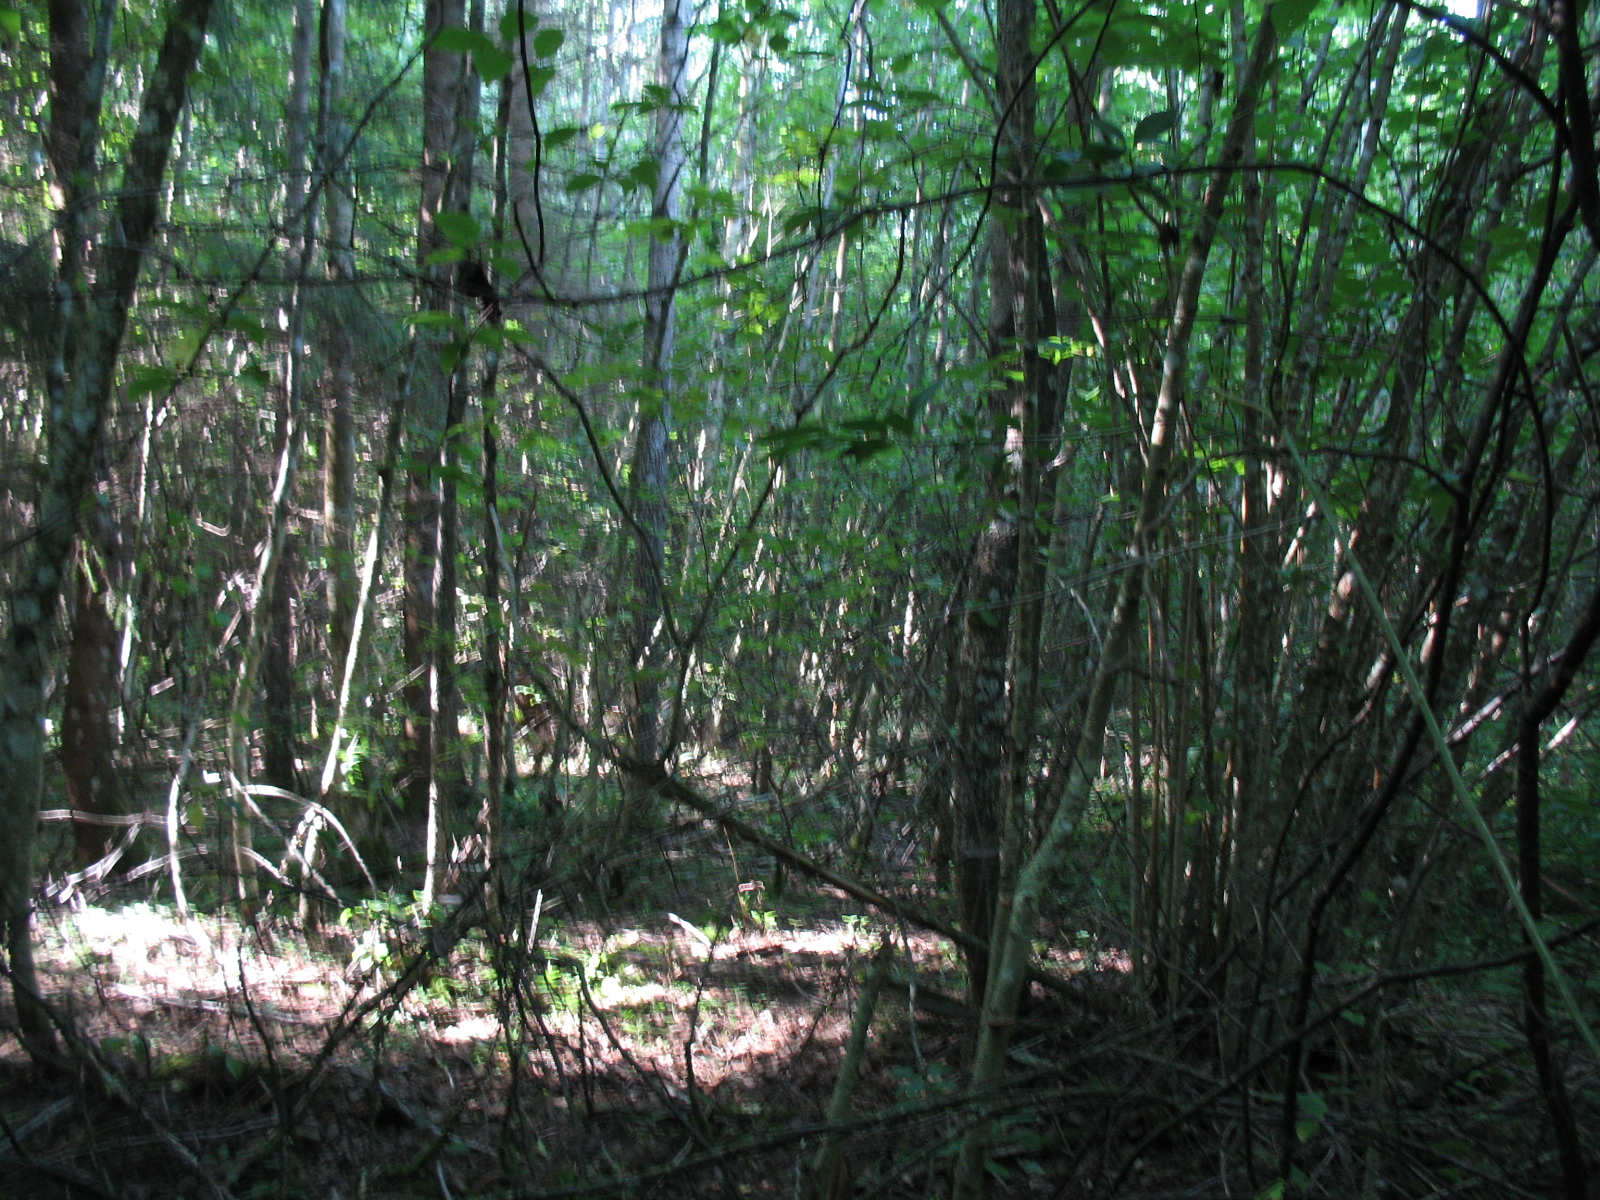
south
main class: Woodland
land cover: Broadleaved woodland
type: non-riverine alder, birch or aspen forest
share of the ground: > 75 %
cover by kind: broadleaved forest trees 90 %, shrubs 5 %, herbaceous plants 5 %
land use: Forestry
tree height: > 5 m
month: July
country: LV
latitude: 56.2224
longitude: 25.0937
